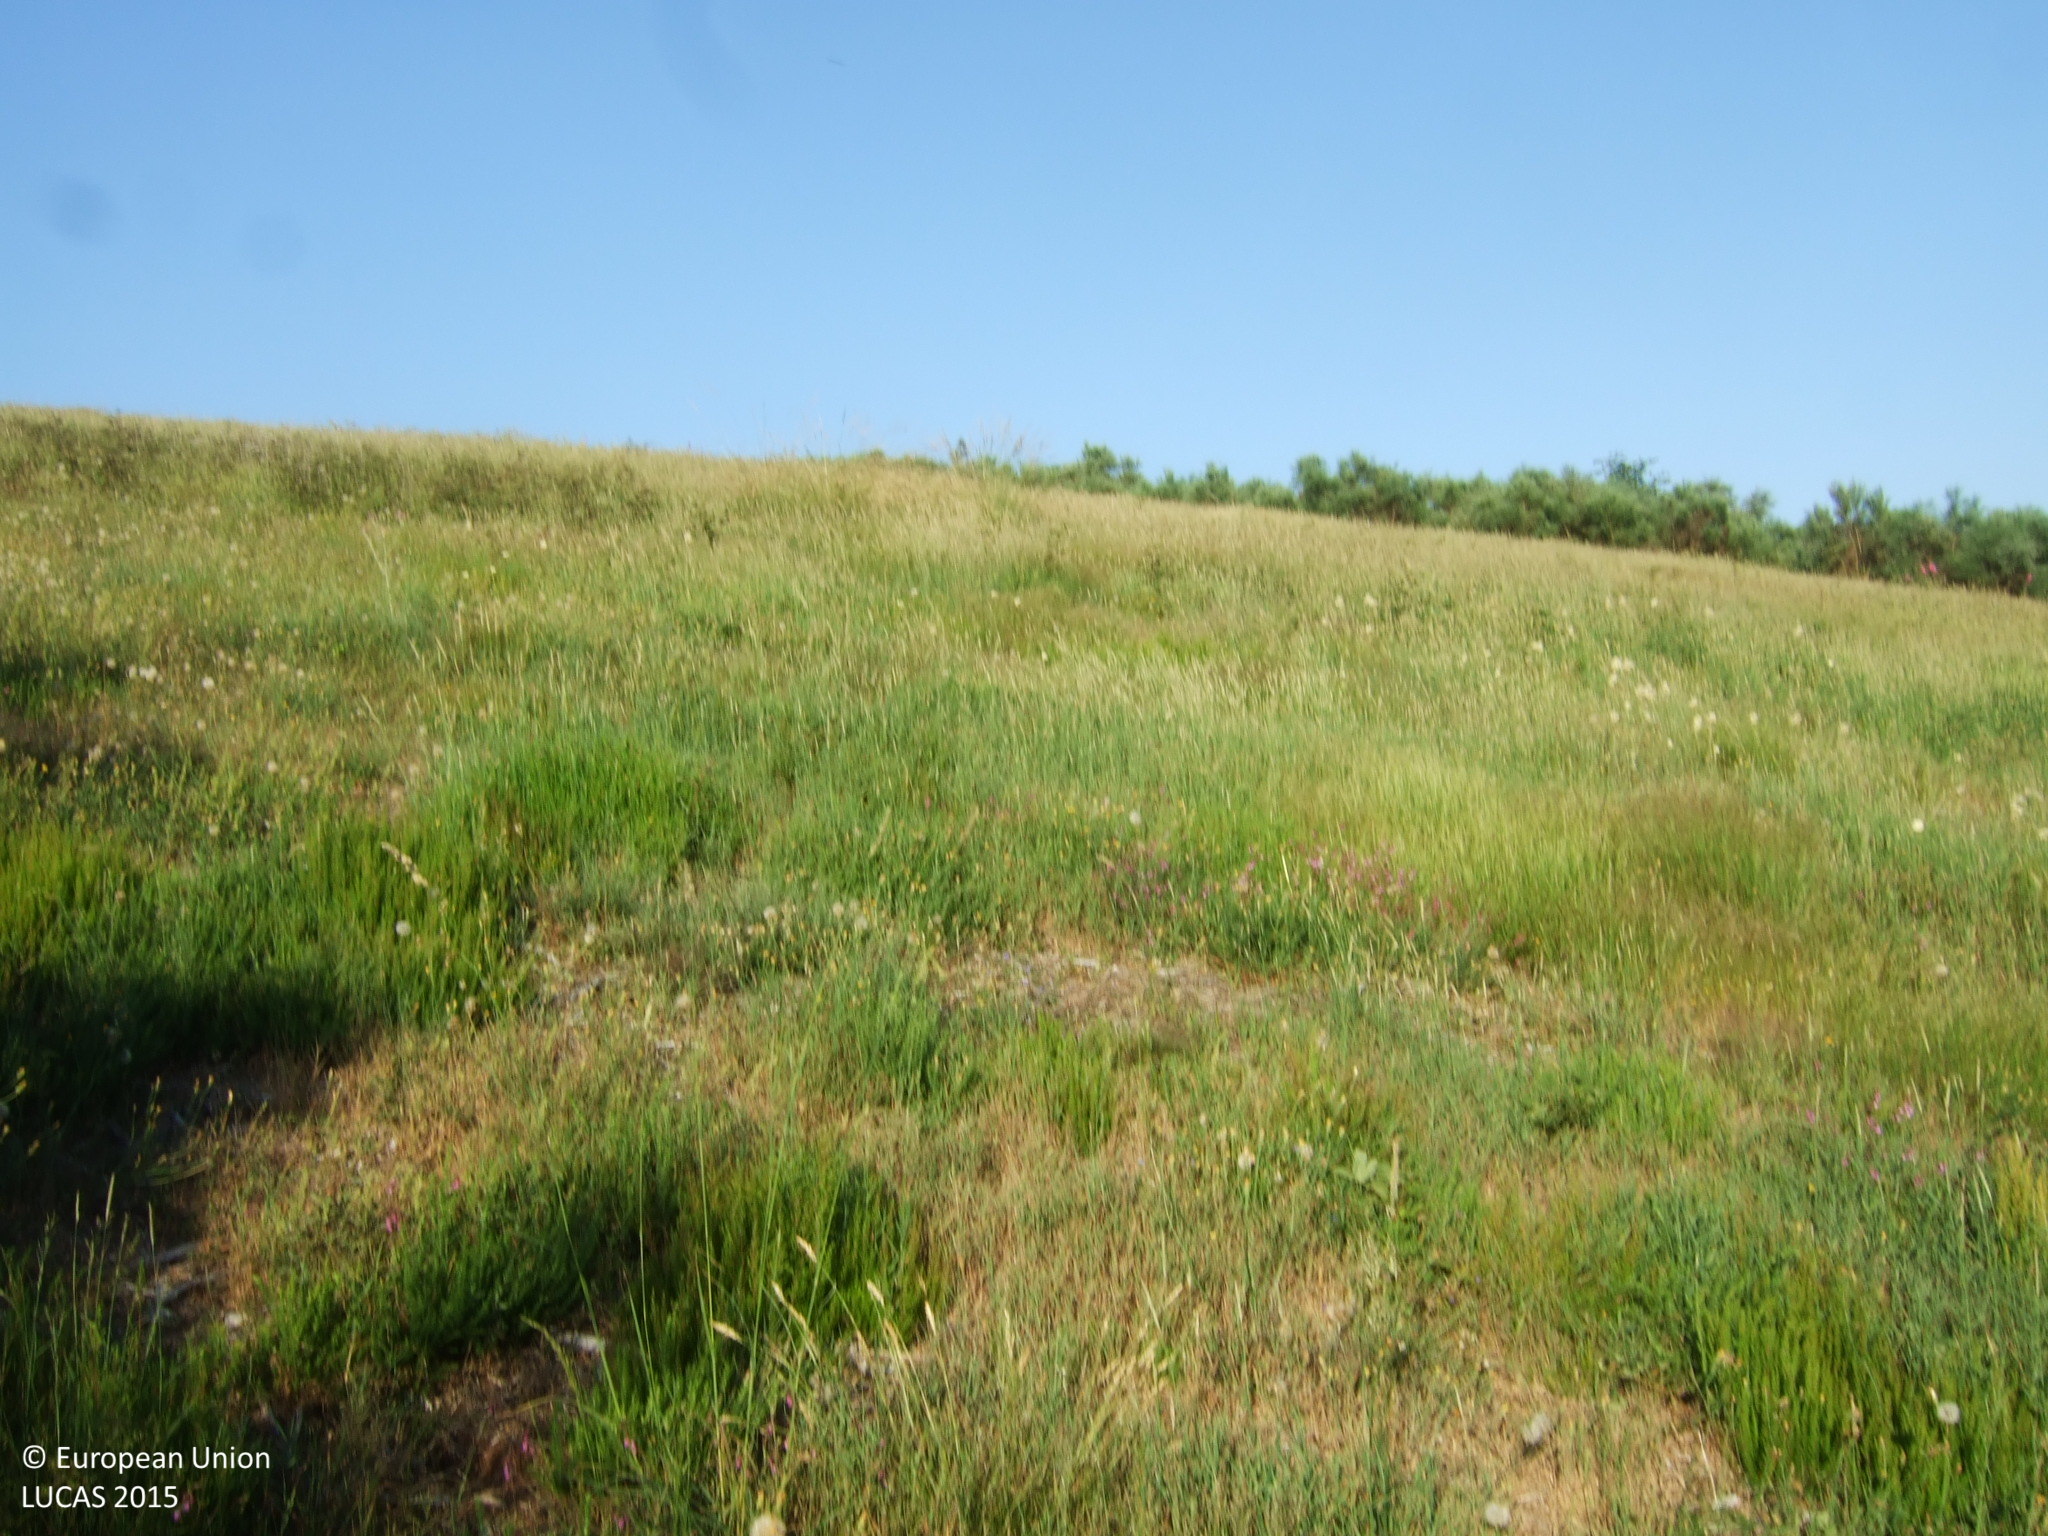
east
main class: Shrubland
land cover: Shrubland without tree cover
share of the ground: > 75 %
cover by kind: shrubs 100 %
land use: Semi-natural and natural areas not in use
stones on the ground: 10 - 25 %
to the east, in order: Shrubland without tree cover; Grassland without tree/shrub cover; Shrubland without tree cover; Tracks; Fences; Grassland without tree/shrub cover
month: June
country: ES
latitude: 42.7369
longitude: -6.9757
